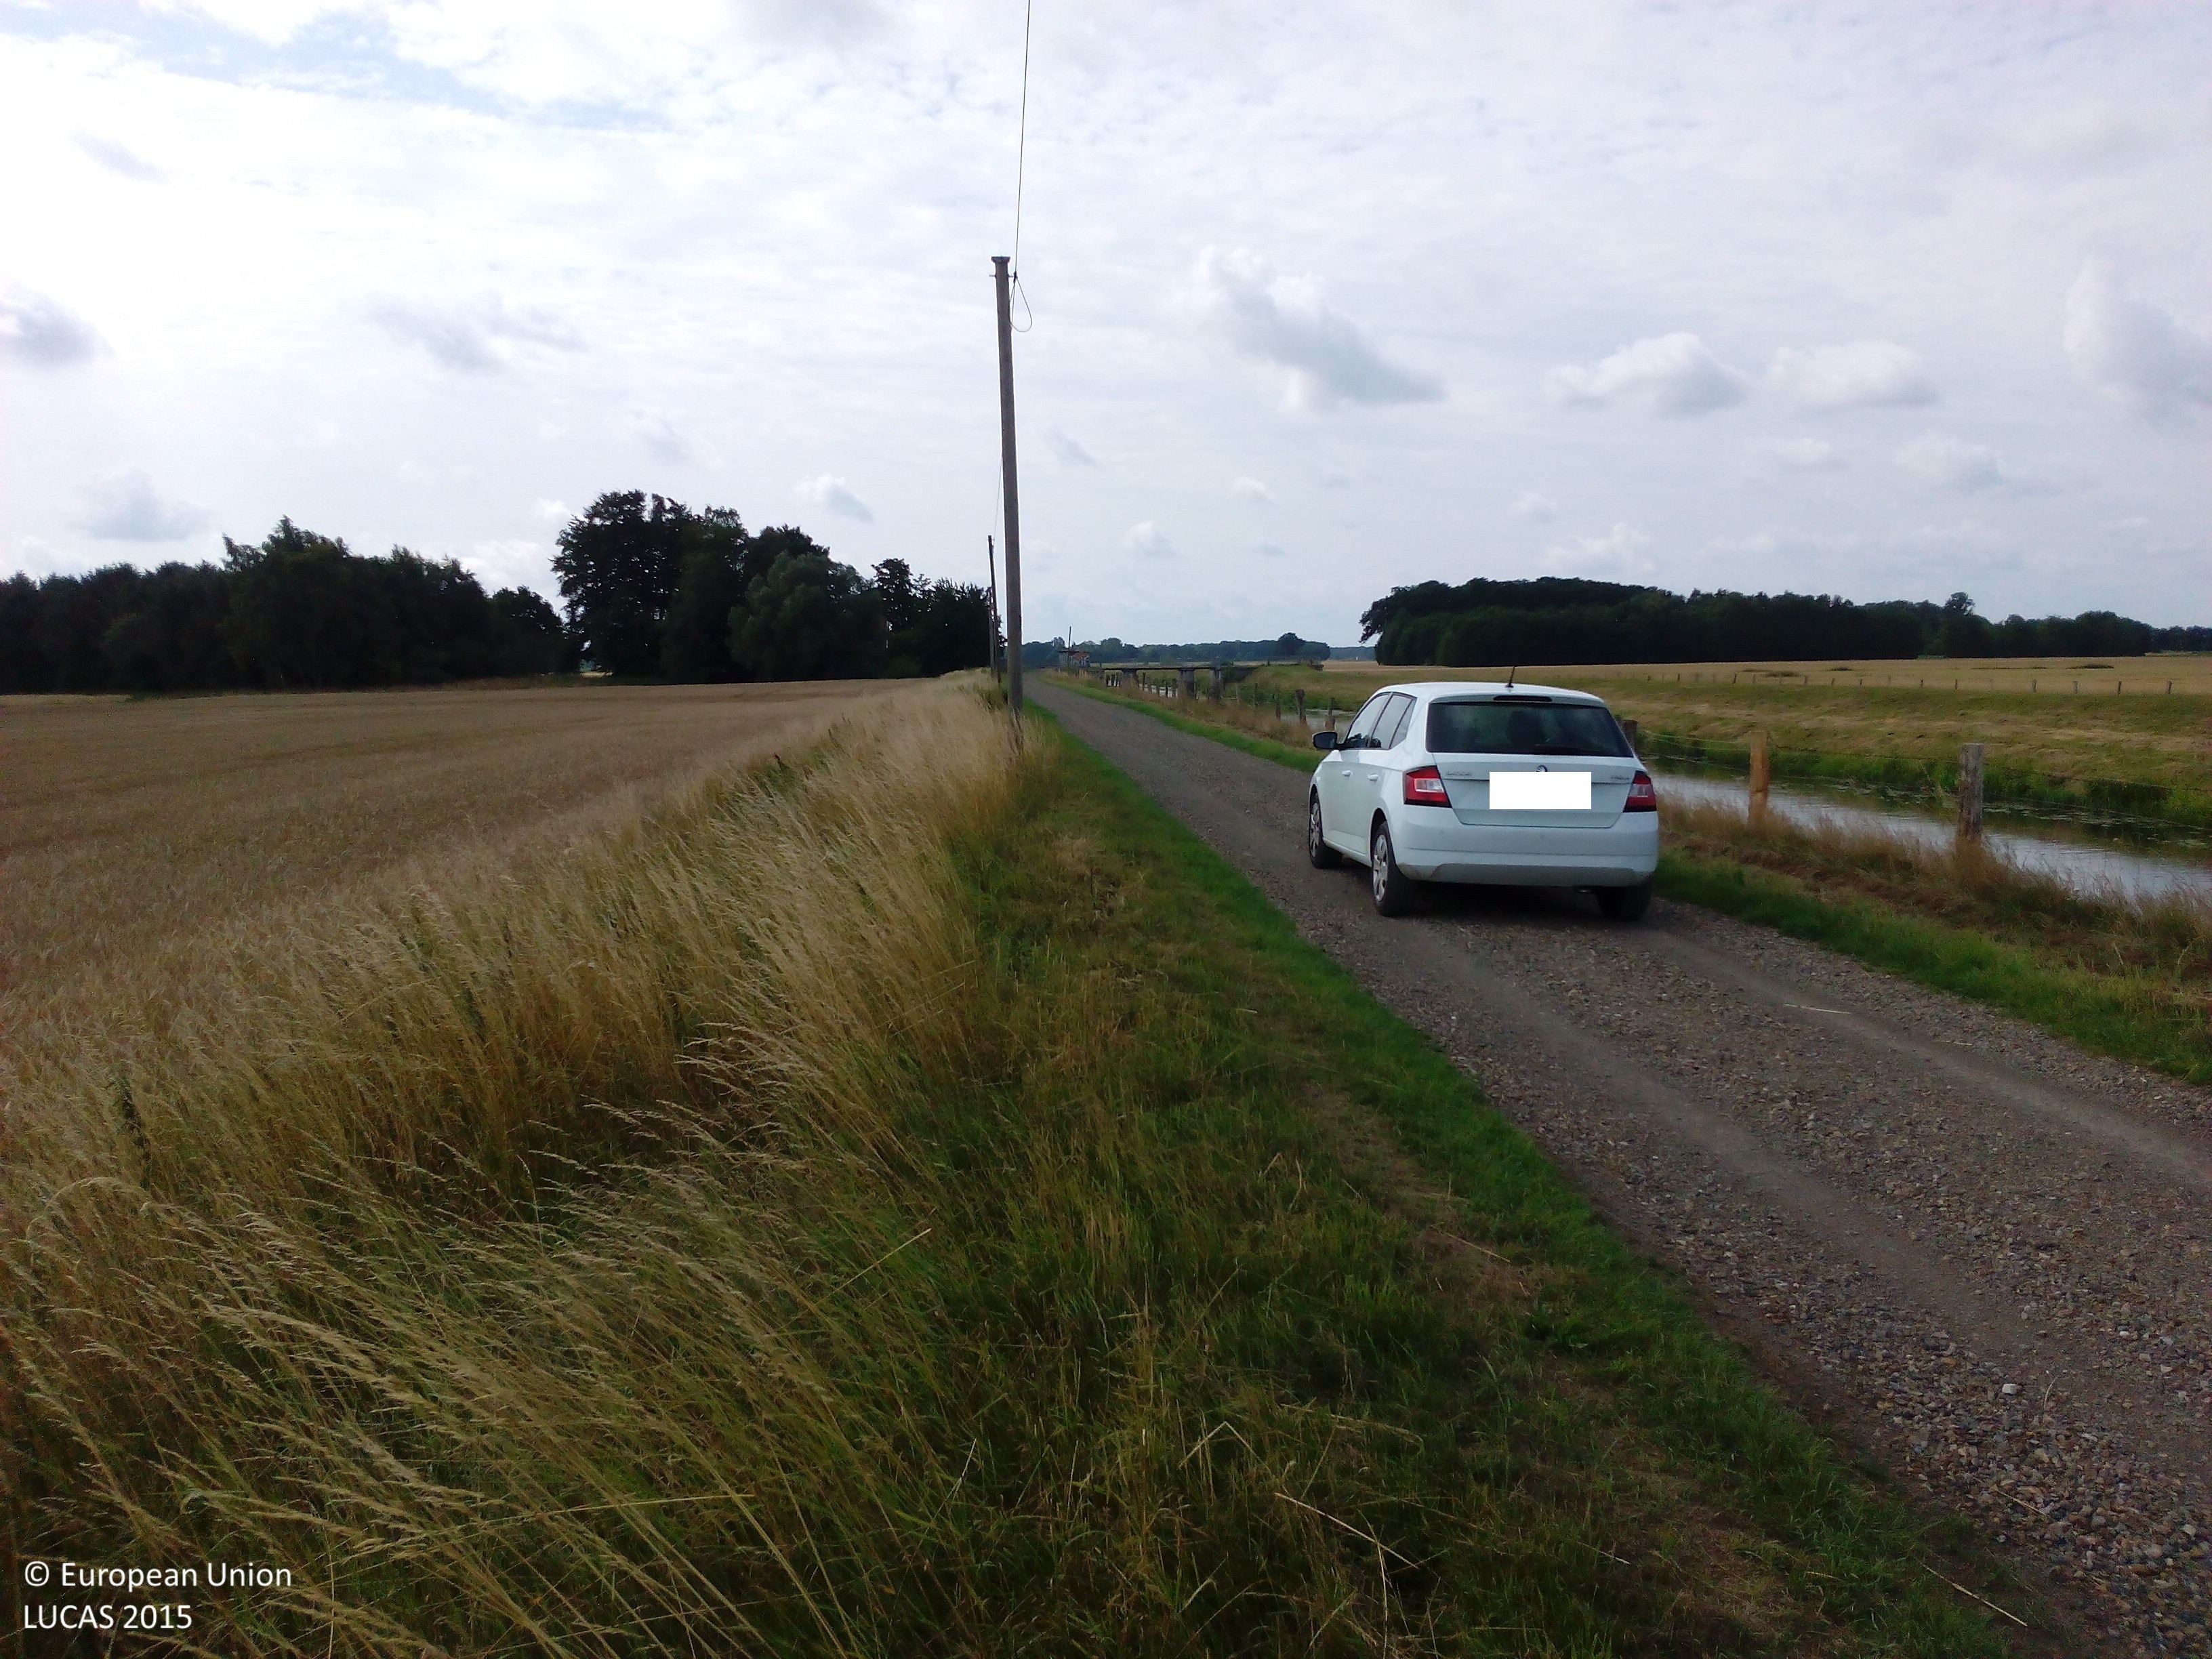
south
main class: Cropland
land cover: Common wheat
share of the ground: > 75 %
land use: Agriculture (excluding fallow land and kitchen gardens)
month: July
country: DE
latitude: 52.6304
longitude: 8.0059
